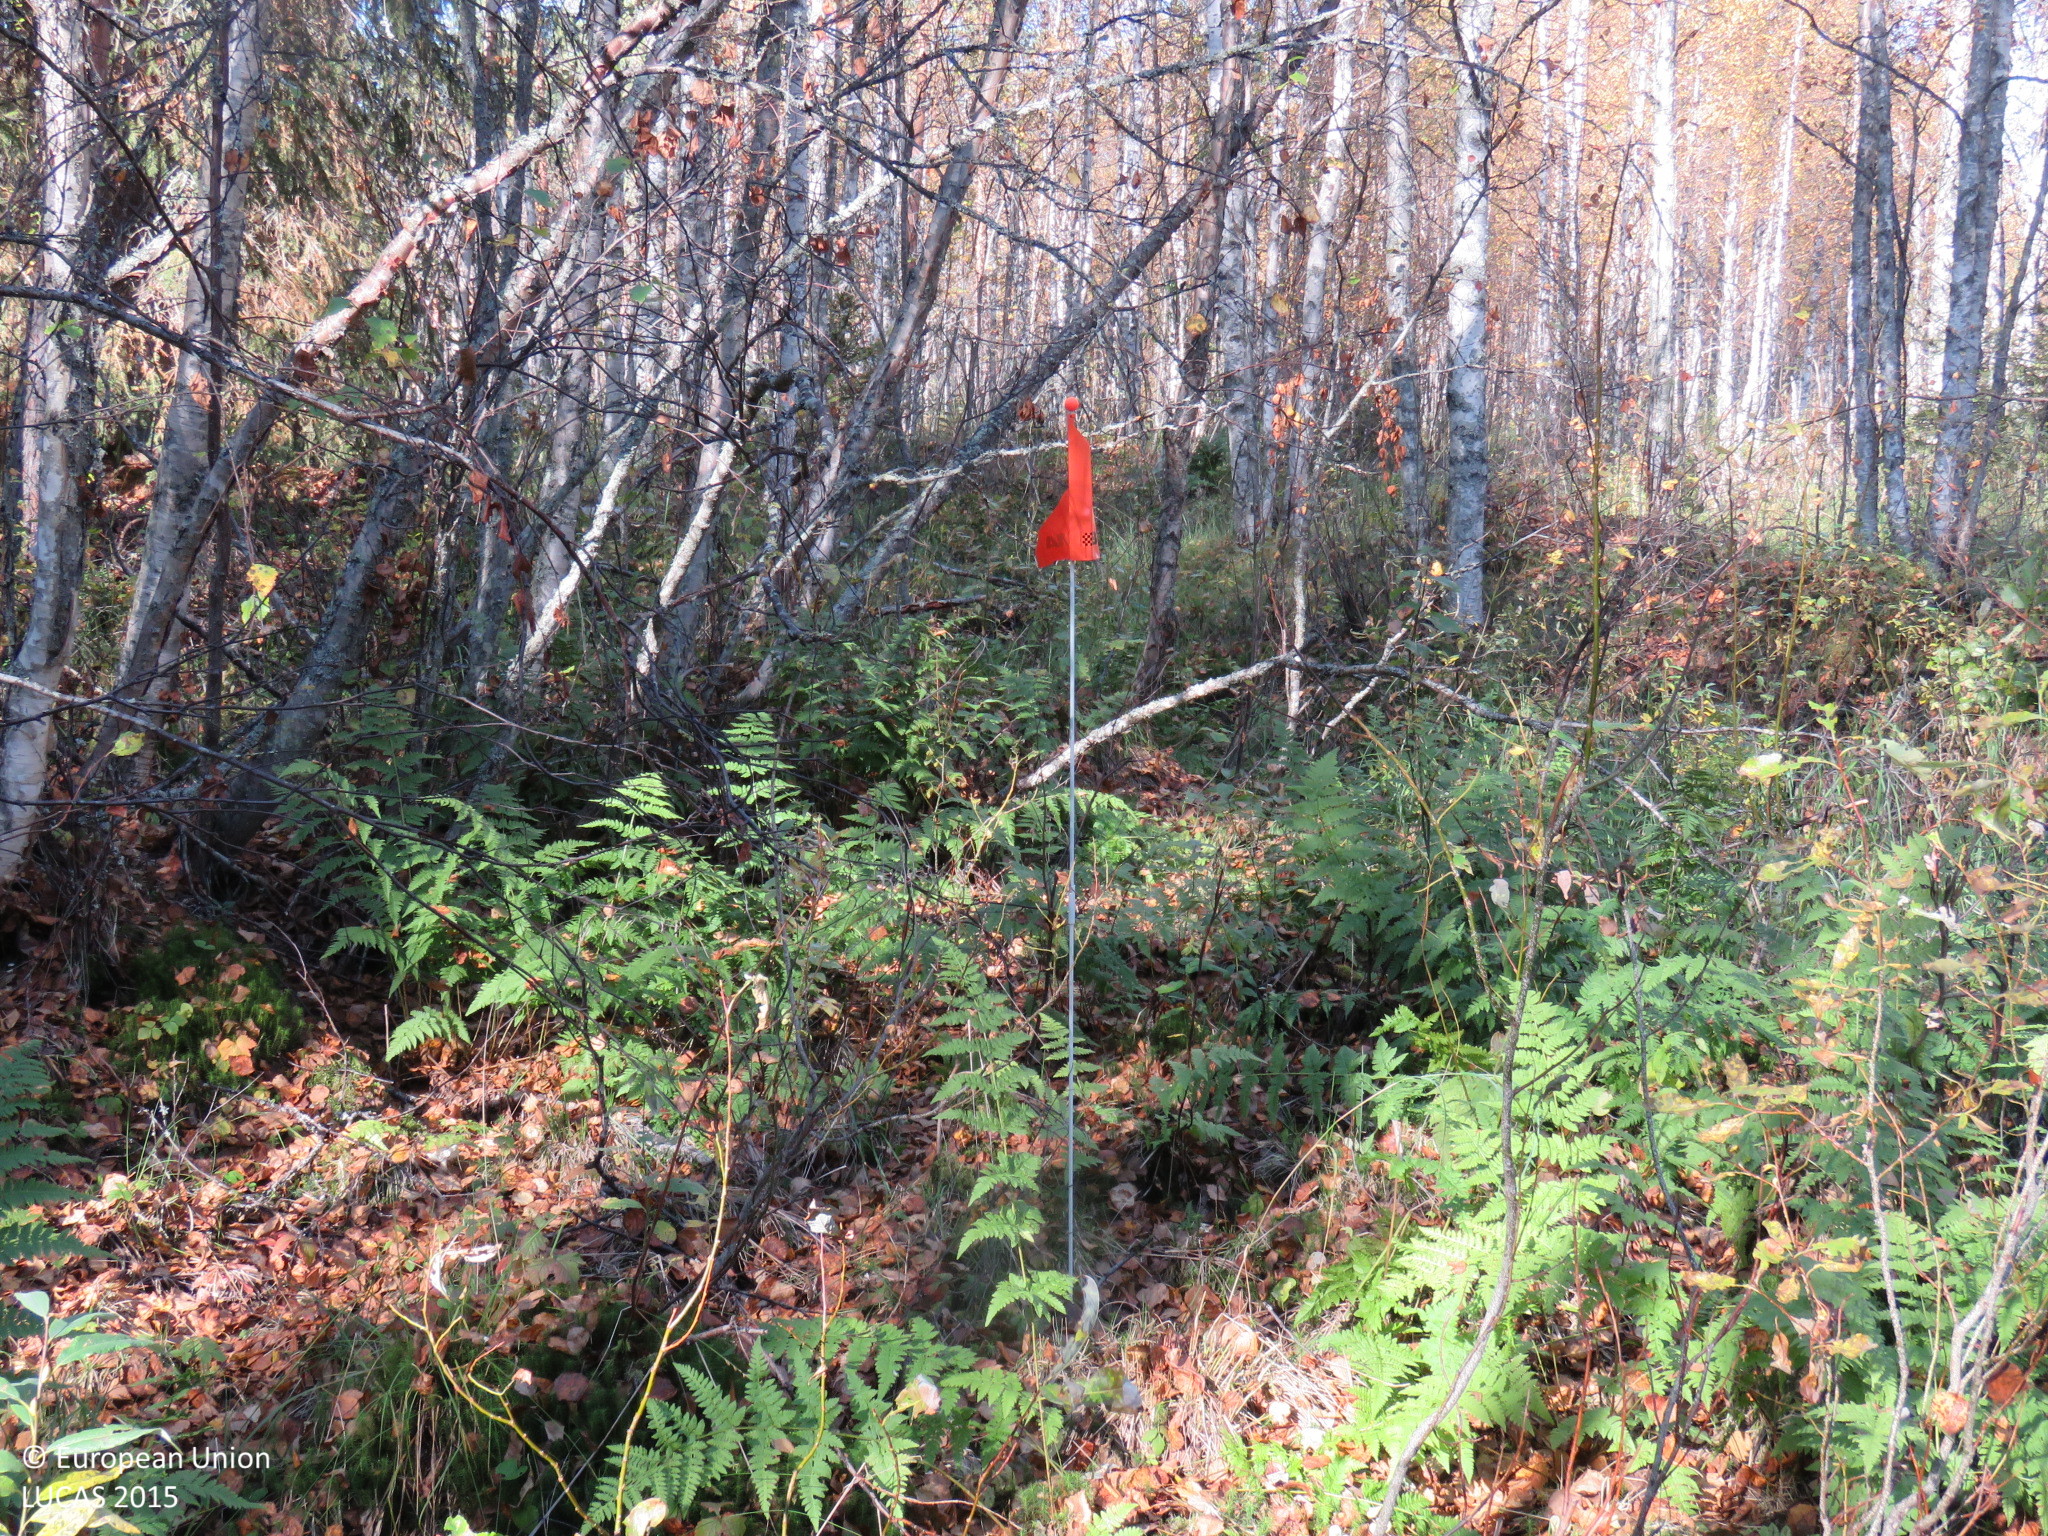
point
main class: Woodland
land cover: Broadleaved woodland
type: mire and swamp forests
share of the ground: > 75 %
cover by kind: broadleaved forest trees 75 %, coniferous forest trees 10 %, herbaceous plants 10 %, lichens and mosses 5 %
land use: Forestry
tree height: > 5 m
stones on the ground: < 10 %
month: September
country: FI
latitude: 64.9441
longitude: 26.9450
